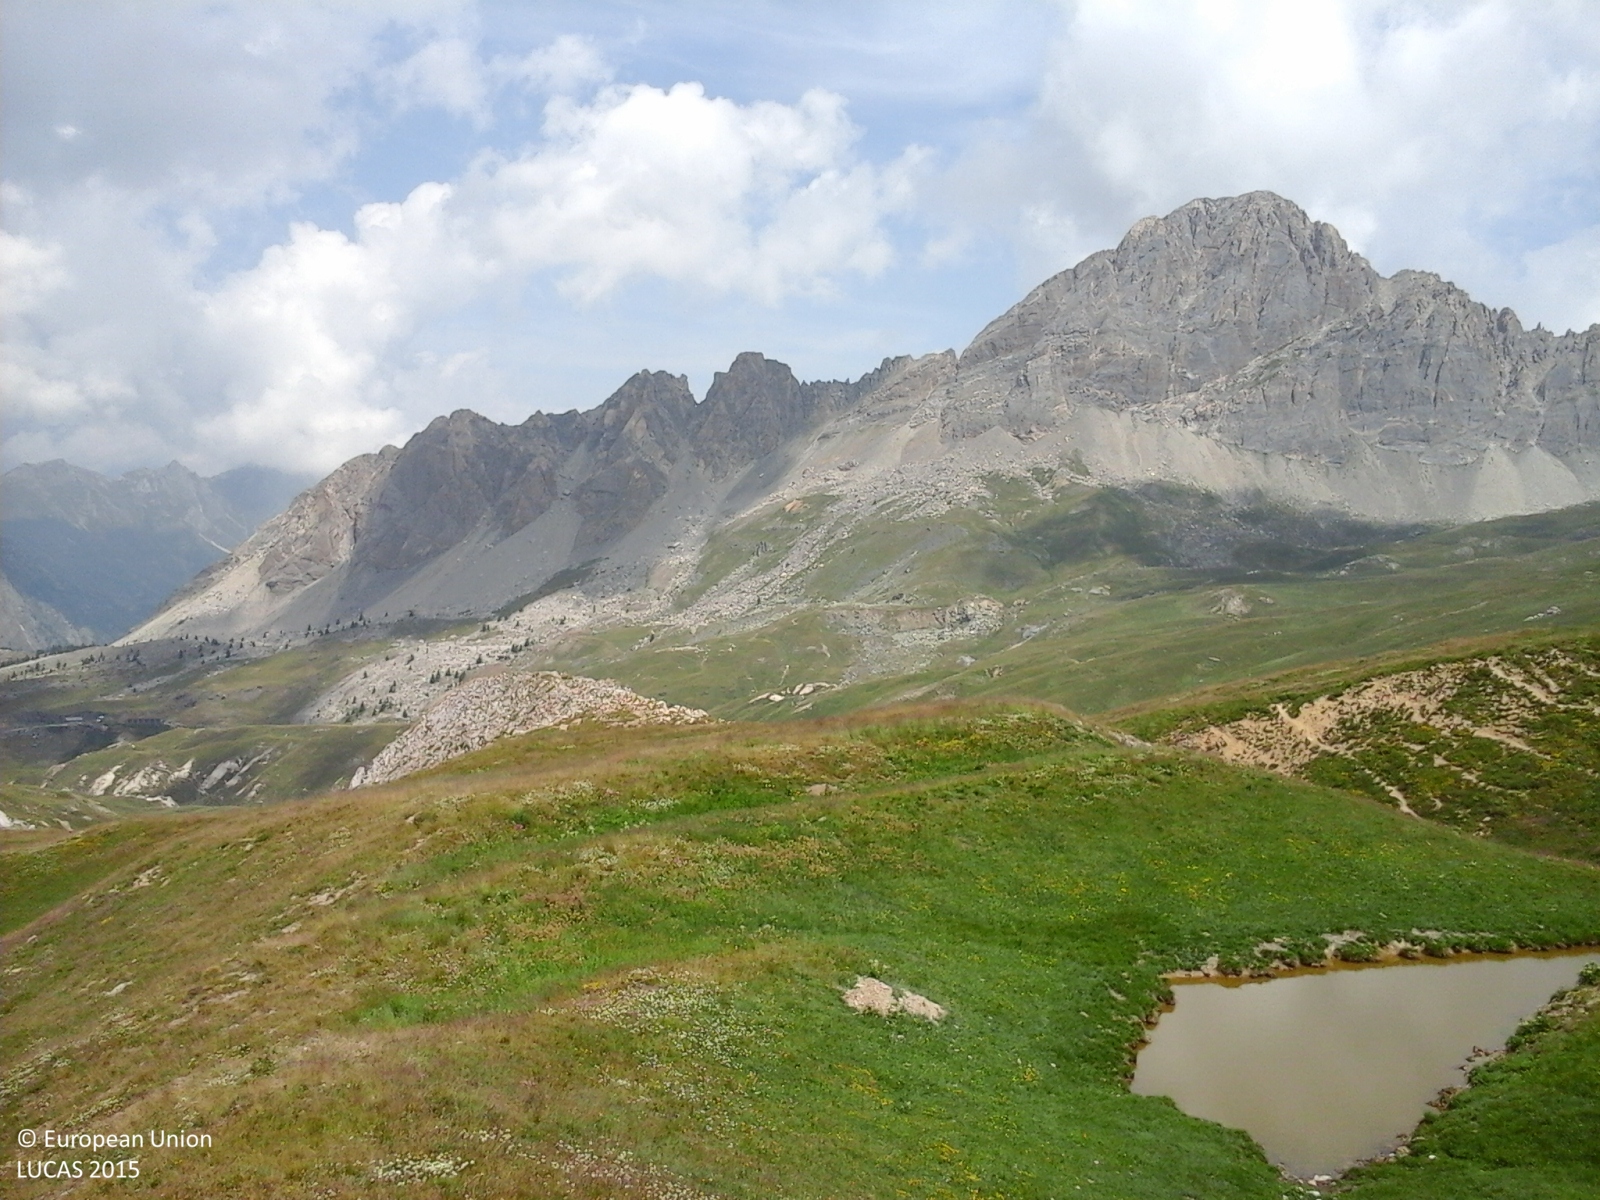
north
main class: Grassland
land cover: Grassland without tree/shrub cover
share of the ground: > 75 %
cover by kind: herbaceous plants 80 %, consolidated bare surface 20 %
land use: Agriculture (excluding fallow land and kitchen gardens)
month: July
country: IT
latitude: 44.3810
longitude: 7.0563
